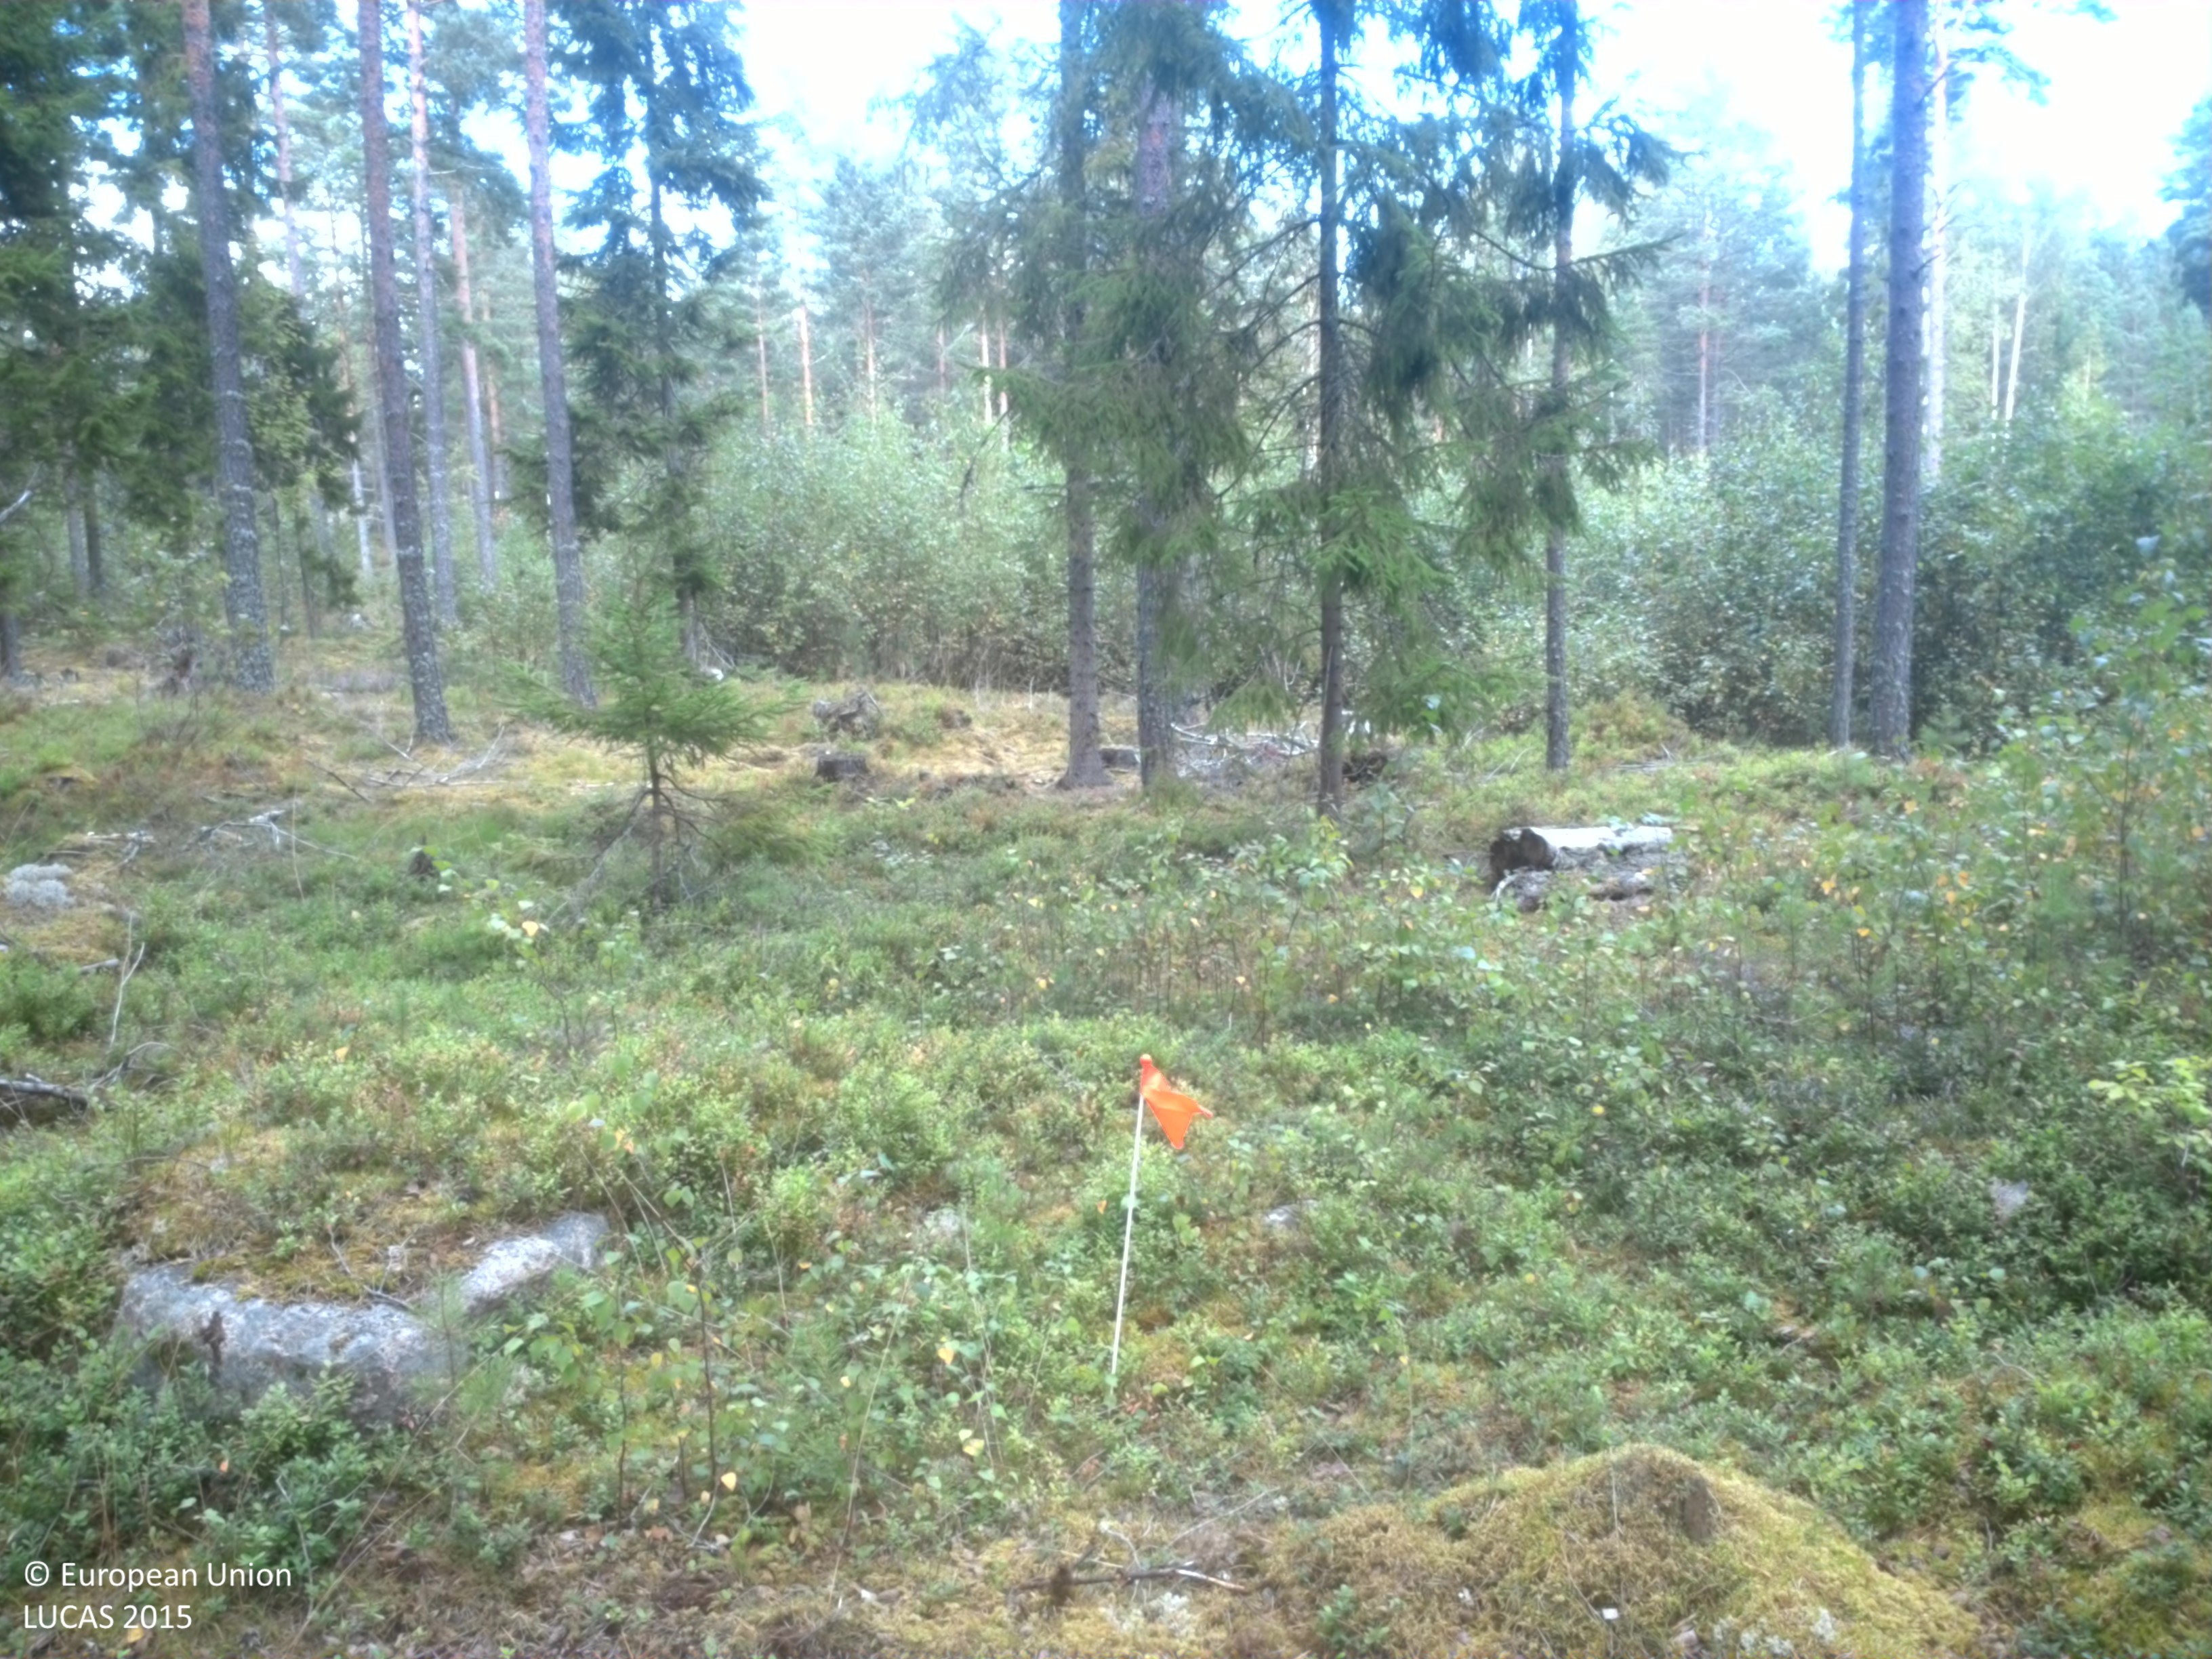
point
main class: Woodland
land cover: Pine dominated coniferous woodland
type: boreal forest
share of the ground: 50 - 75 %
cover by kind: coniferous forest trees 45 %, shrubs 30 %, lichens and mosses 20 %, broadleaved forest trees 5 %
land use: Forestry
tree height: > 5 m
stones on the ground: < 10 %
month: August
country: SE
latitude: 59.4551
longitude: 15.6188
